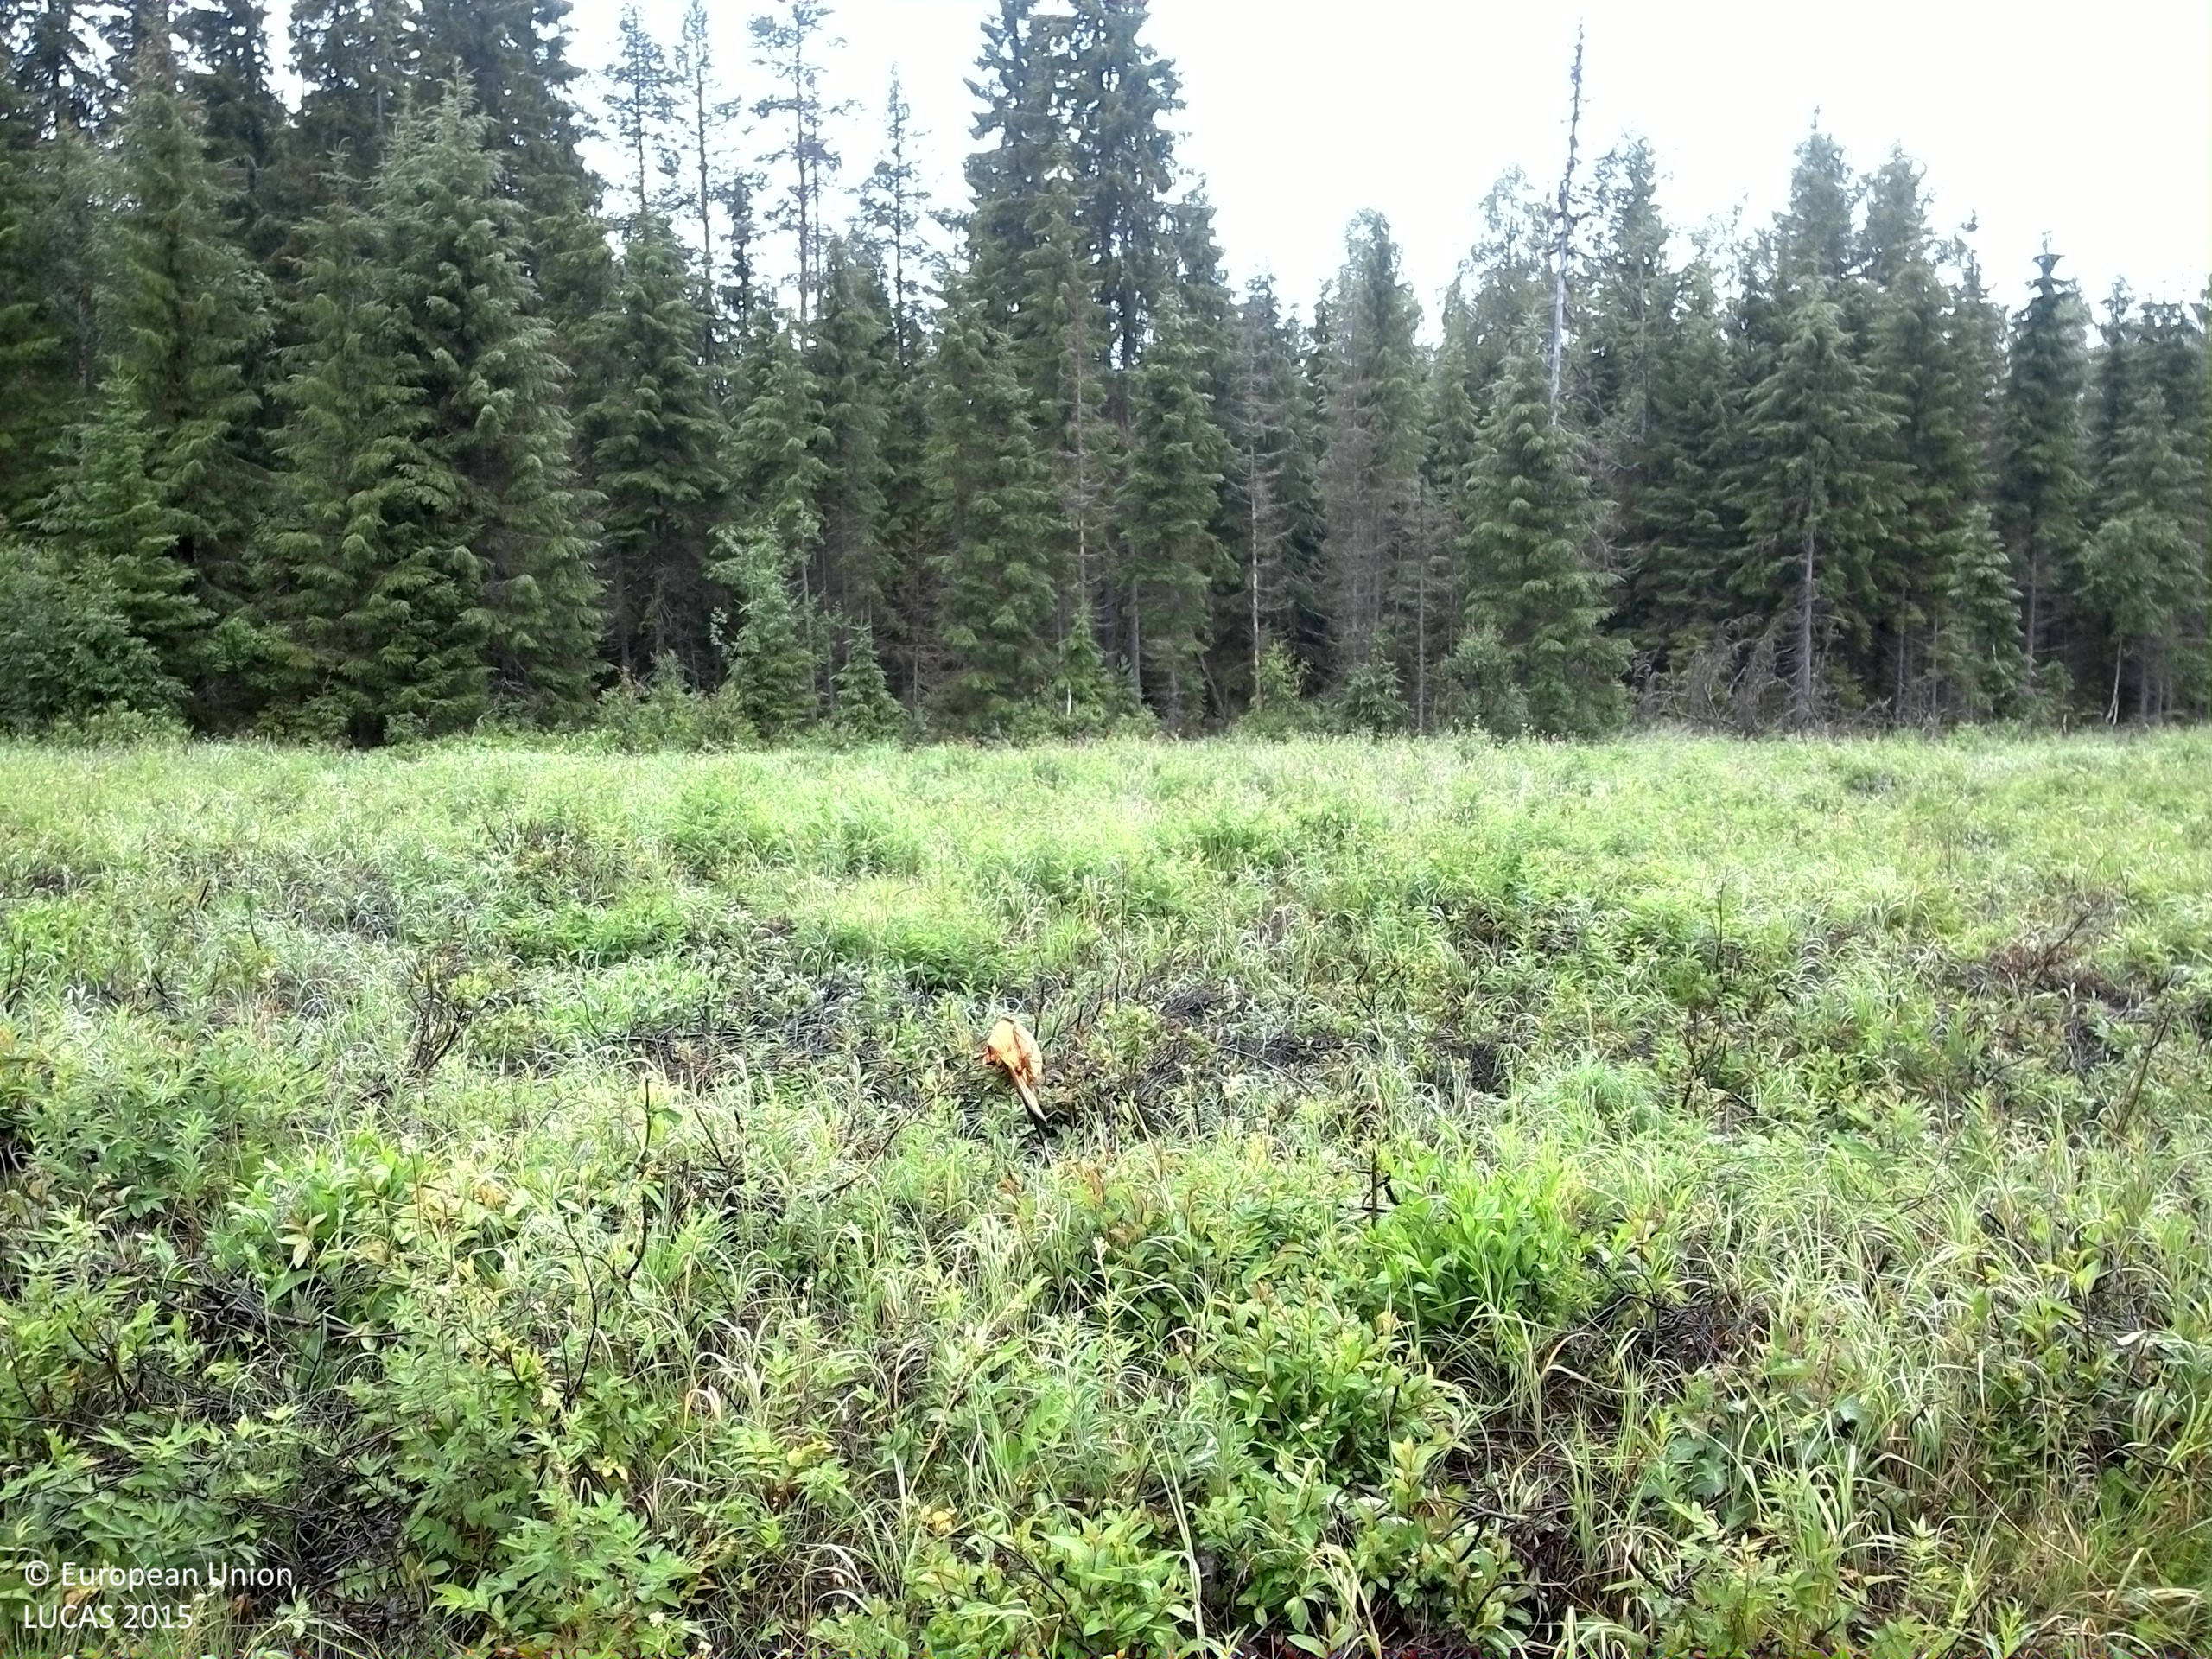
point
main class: Artificial land
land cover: Other artificial areas
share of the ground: 10 - 25 %
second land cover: Shrubland without tree cover
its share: > 75 %
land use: Electricity, gas and thermal power distribution
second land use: Amenities, museums, leisure
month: July
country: SE
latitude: 63.5485
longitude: 18.5679
